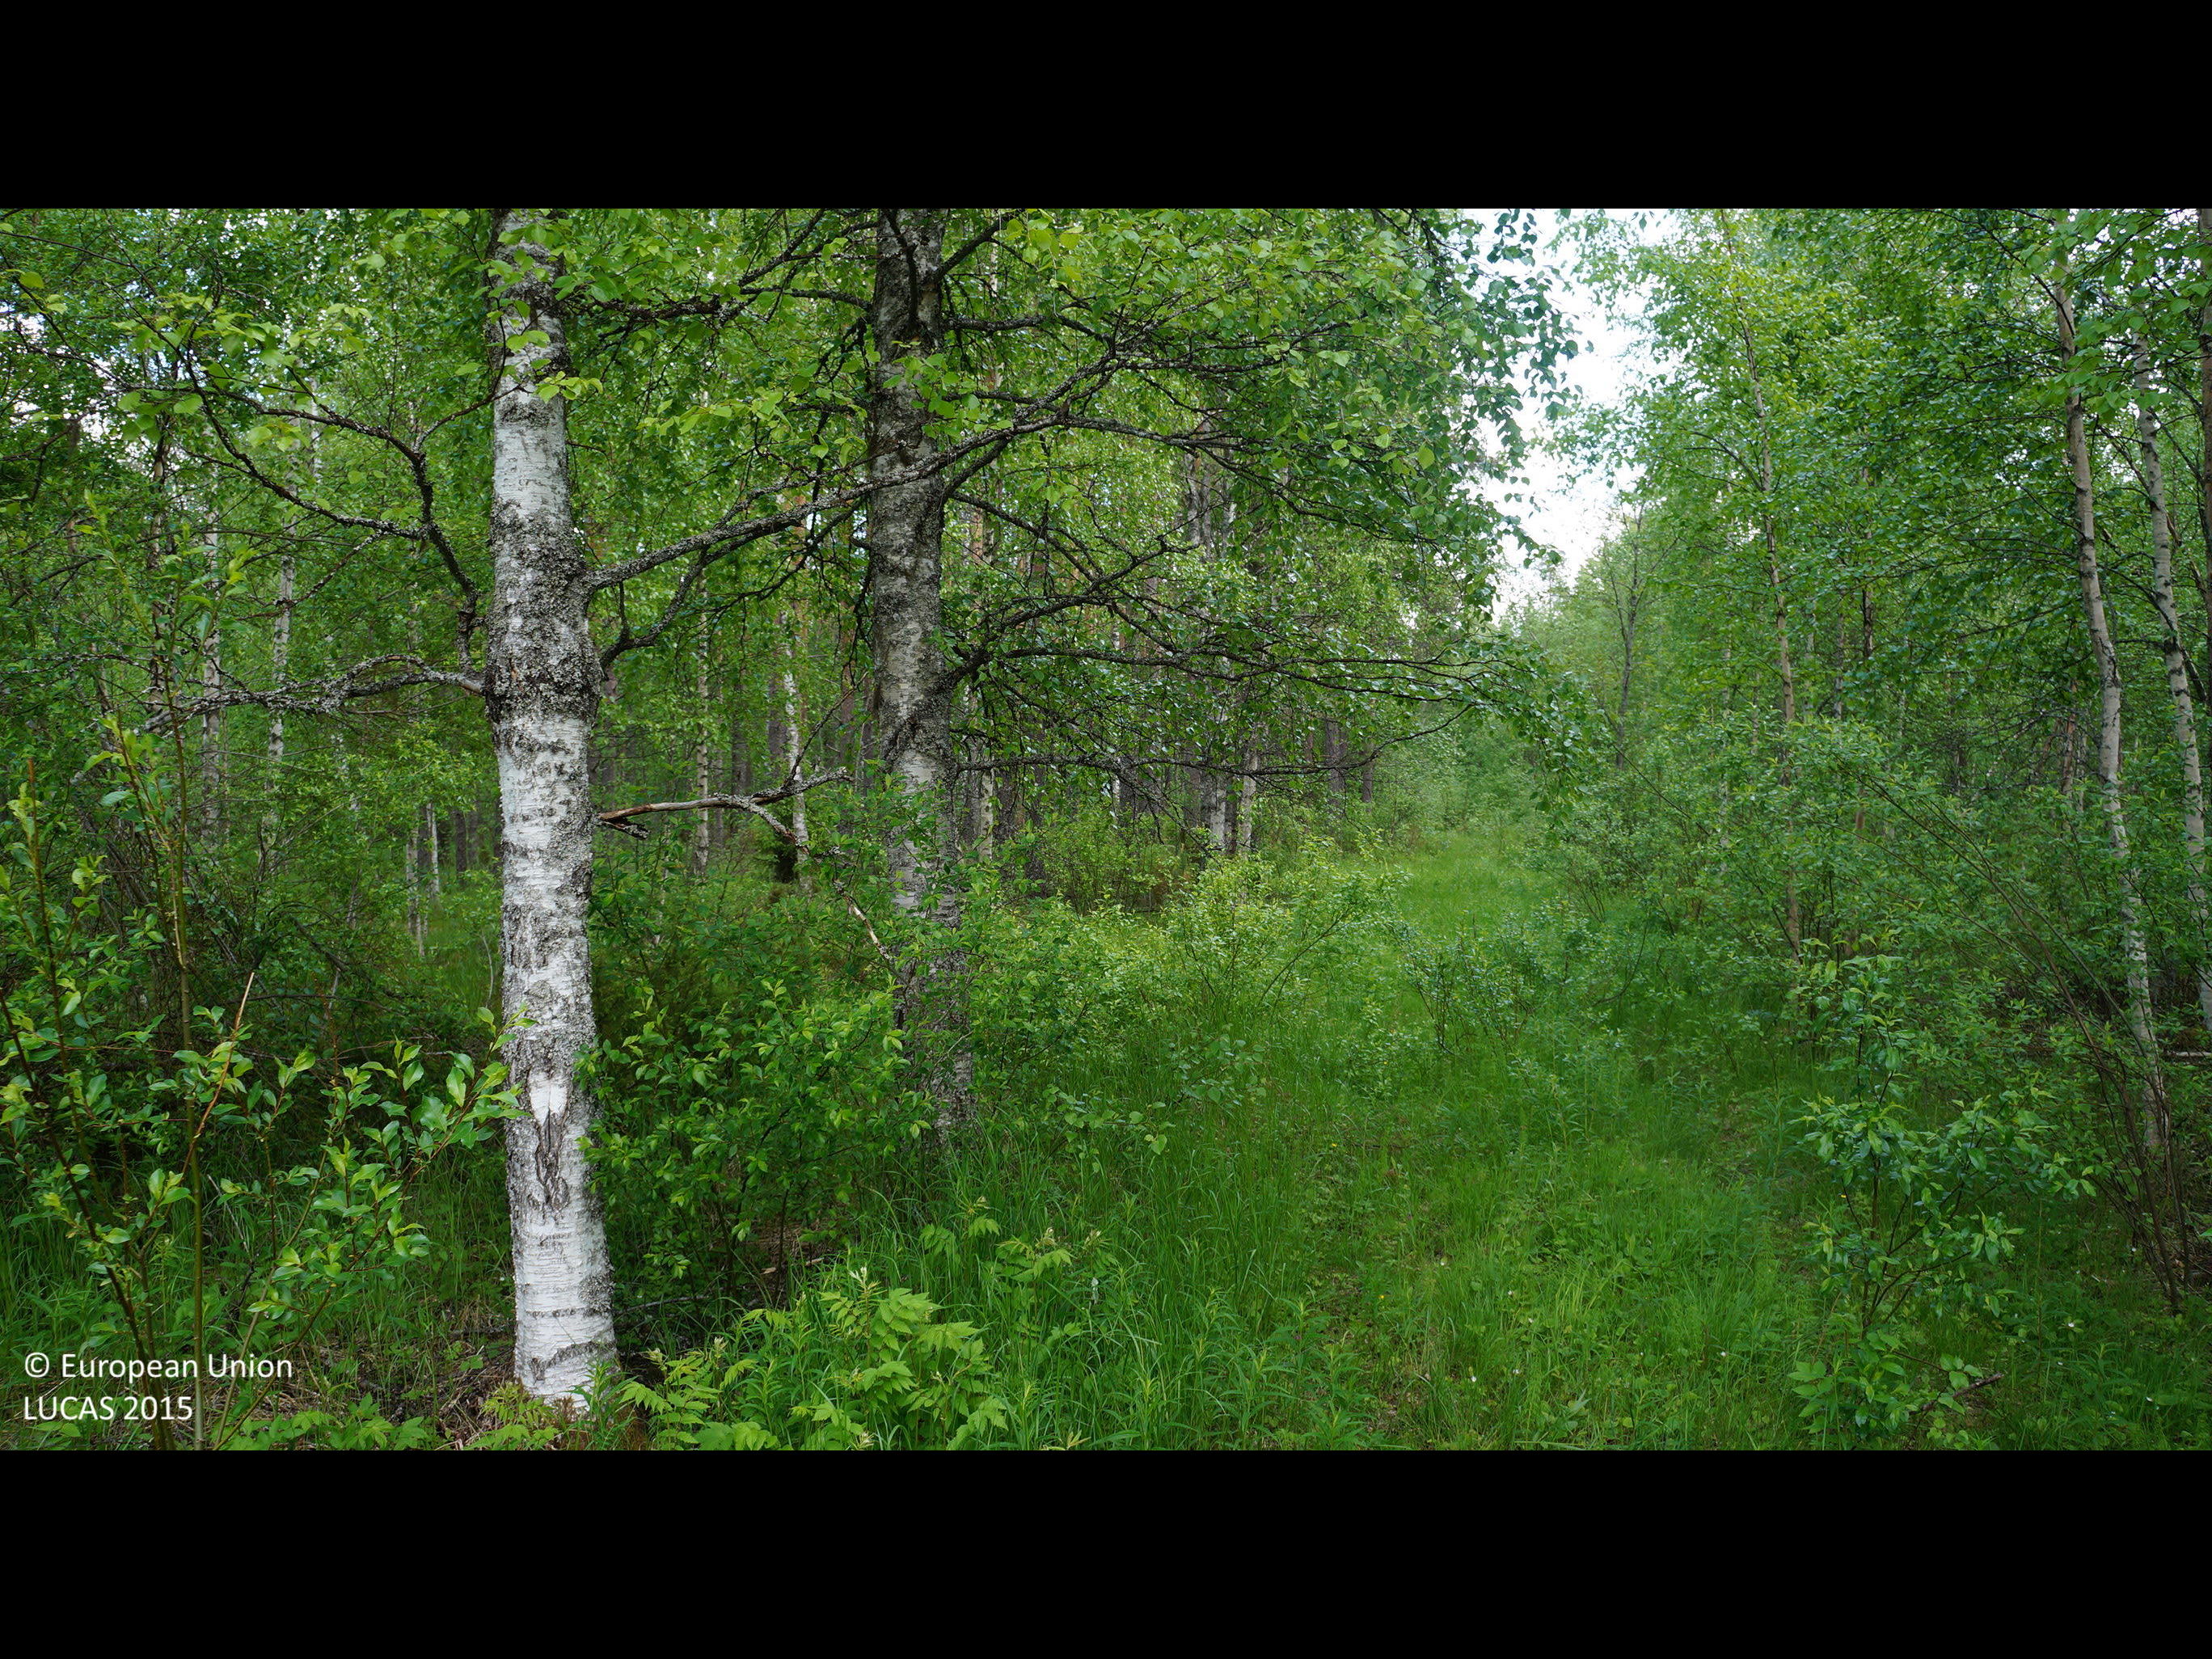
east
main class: Woodland
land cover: Broadleaved woodland
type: non-riverine alder, birch or aspen forest
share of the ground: 50 - 75 %
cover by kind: broadleaved forest trees 60 %, shrubs 20 %, herbaceous plants 15 %, coniferous forest trees 5 %
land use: Forestry
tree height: > 5 m
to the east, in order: Broadleaved woodland; Ditches and canals; Broadleaved woodland; Ditches and canals; Pine dominated mixed woodland; Spruce dominated mixed woodland; Ditches and canals; Other mixed woodland; Ditches and canals; Lines of trees; Grassland without tree/shrub cover; Other mixed woodland; Ditches and canals; Grass margins; Paved roads, cycling and walking lanes; Grass margins; Ditches and canals; Abandoned hedges; Pine dominated coniferous woodland; Other mixed woodland; Ditches and canals; Other mixed woodland
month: June
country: FI
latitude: 64.0920
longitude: 25.1226
